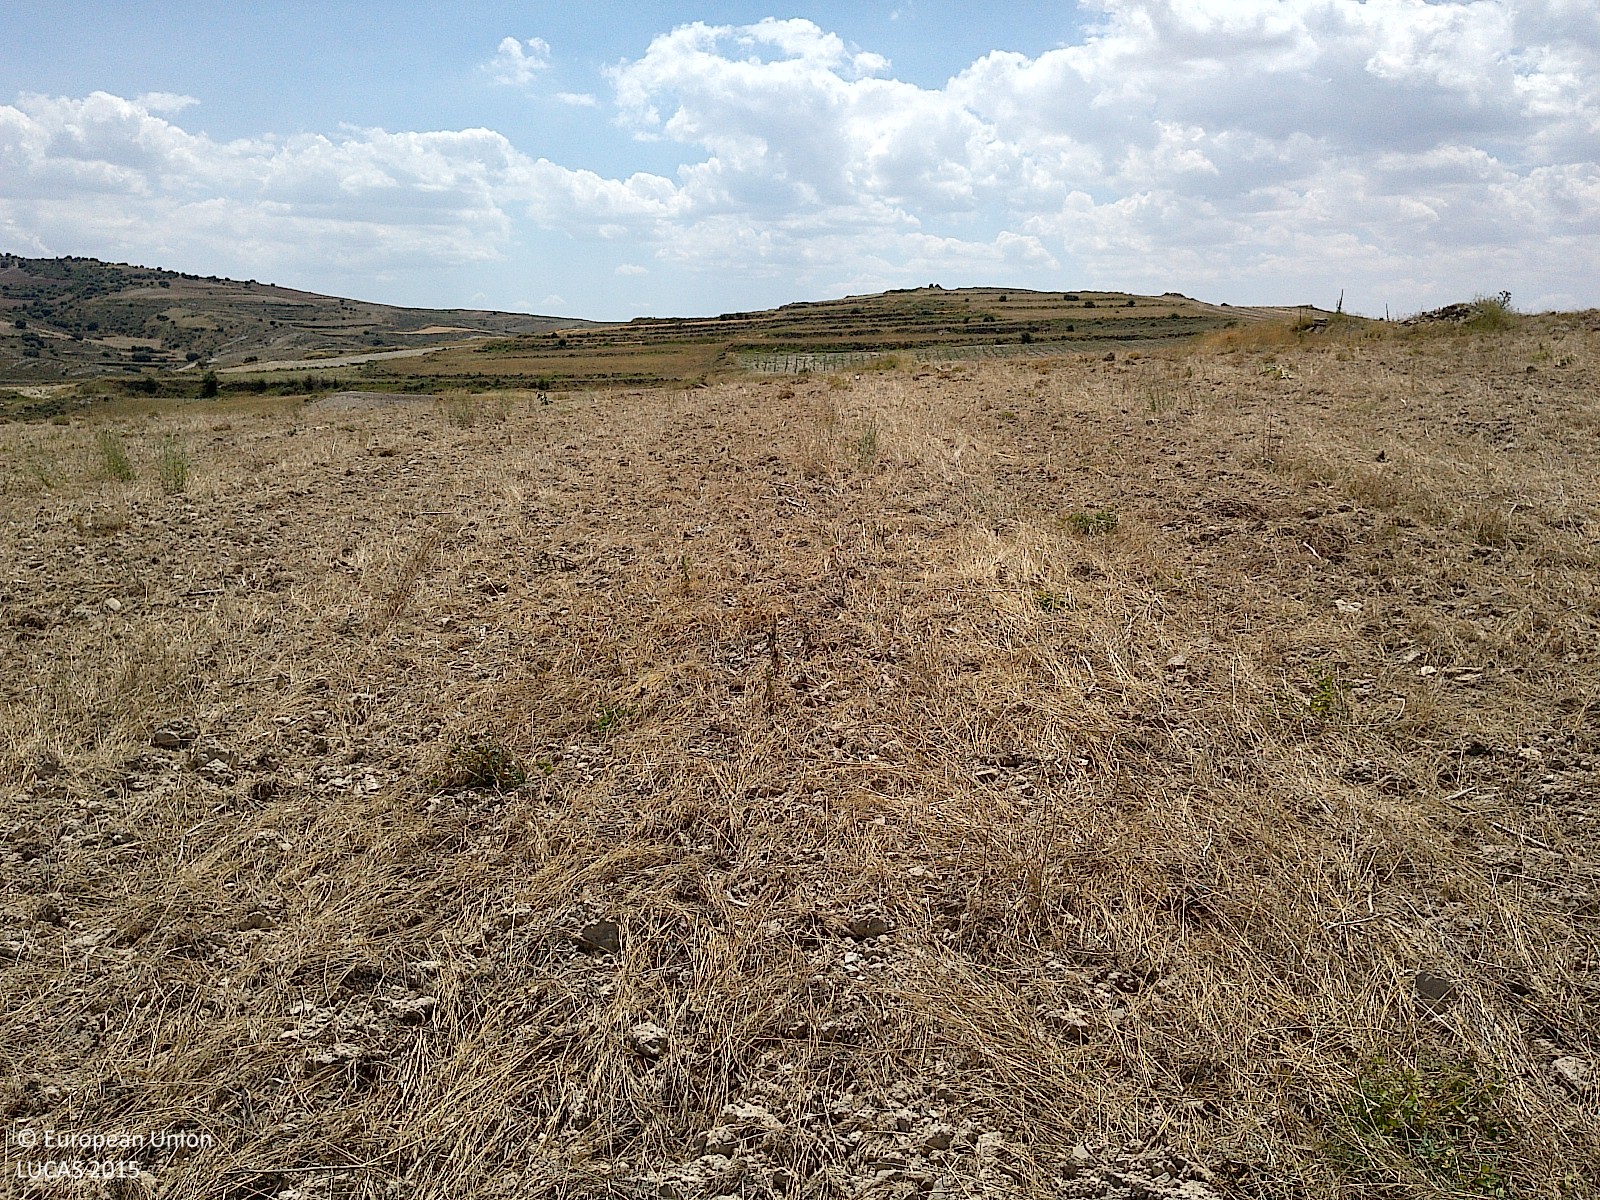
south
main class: Grassland
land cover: Spontaneously vegetated surfaces
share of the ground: 25 - 50 %
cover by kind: unconsolidated bare surface 70 %, herbaceous plants 30 %
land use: Fallow land
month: July
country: ES
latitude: 41.9158
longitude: -2.0314
